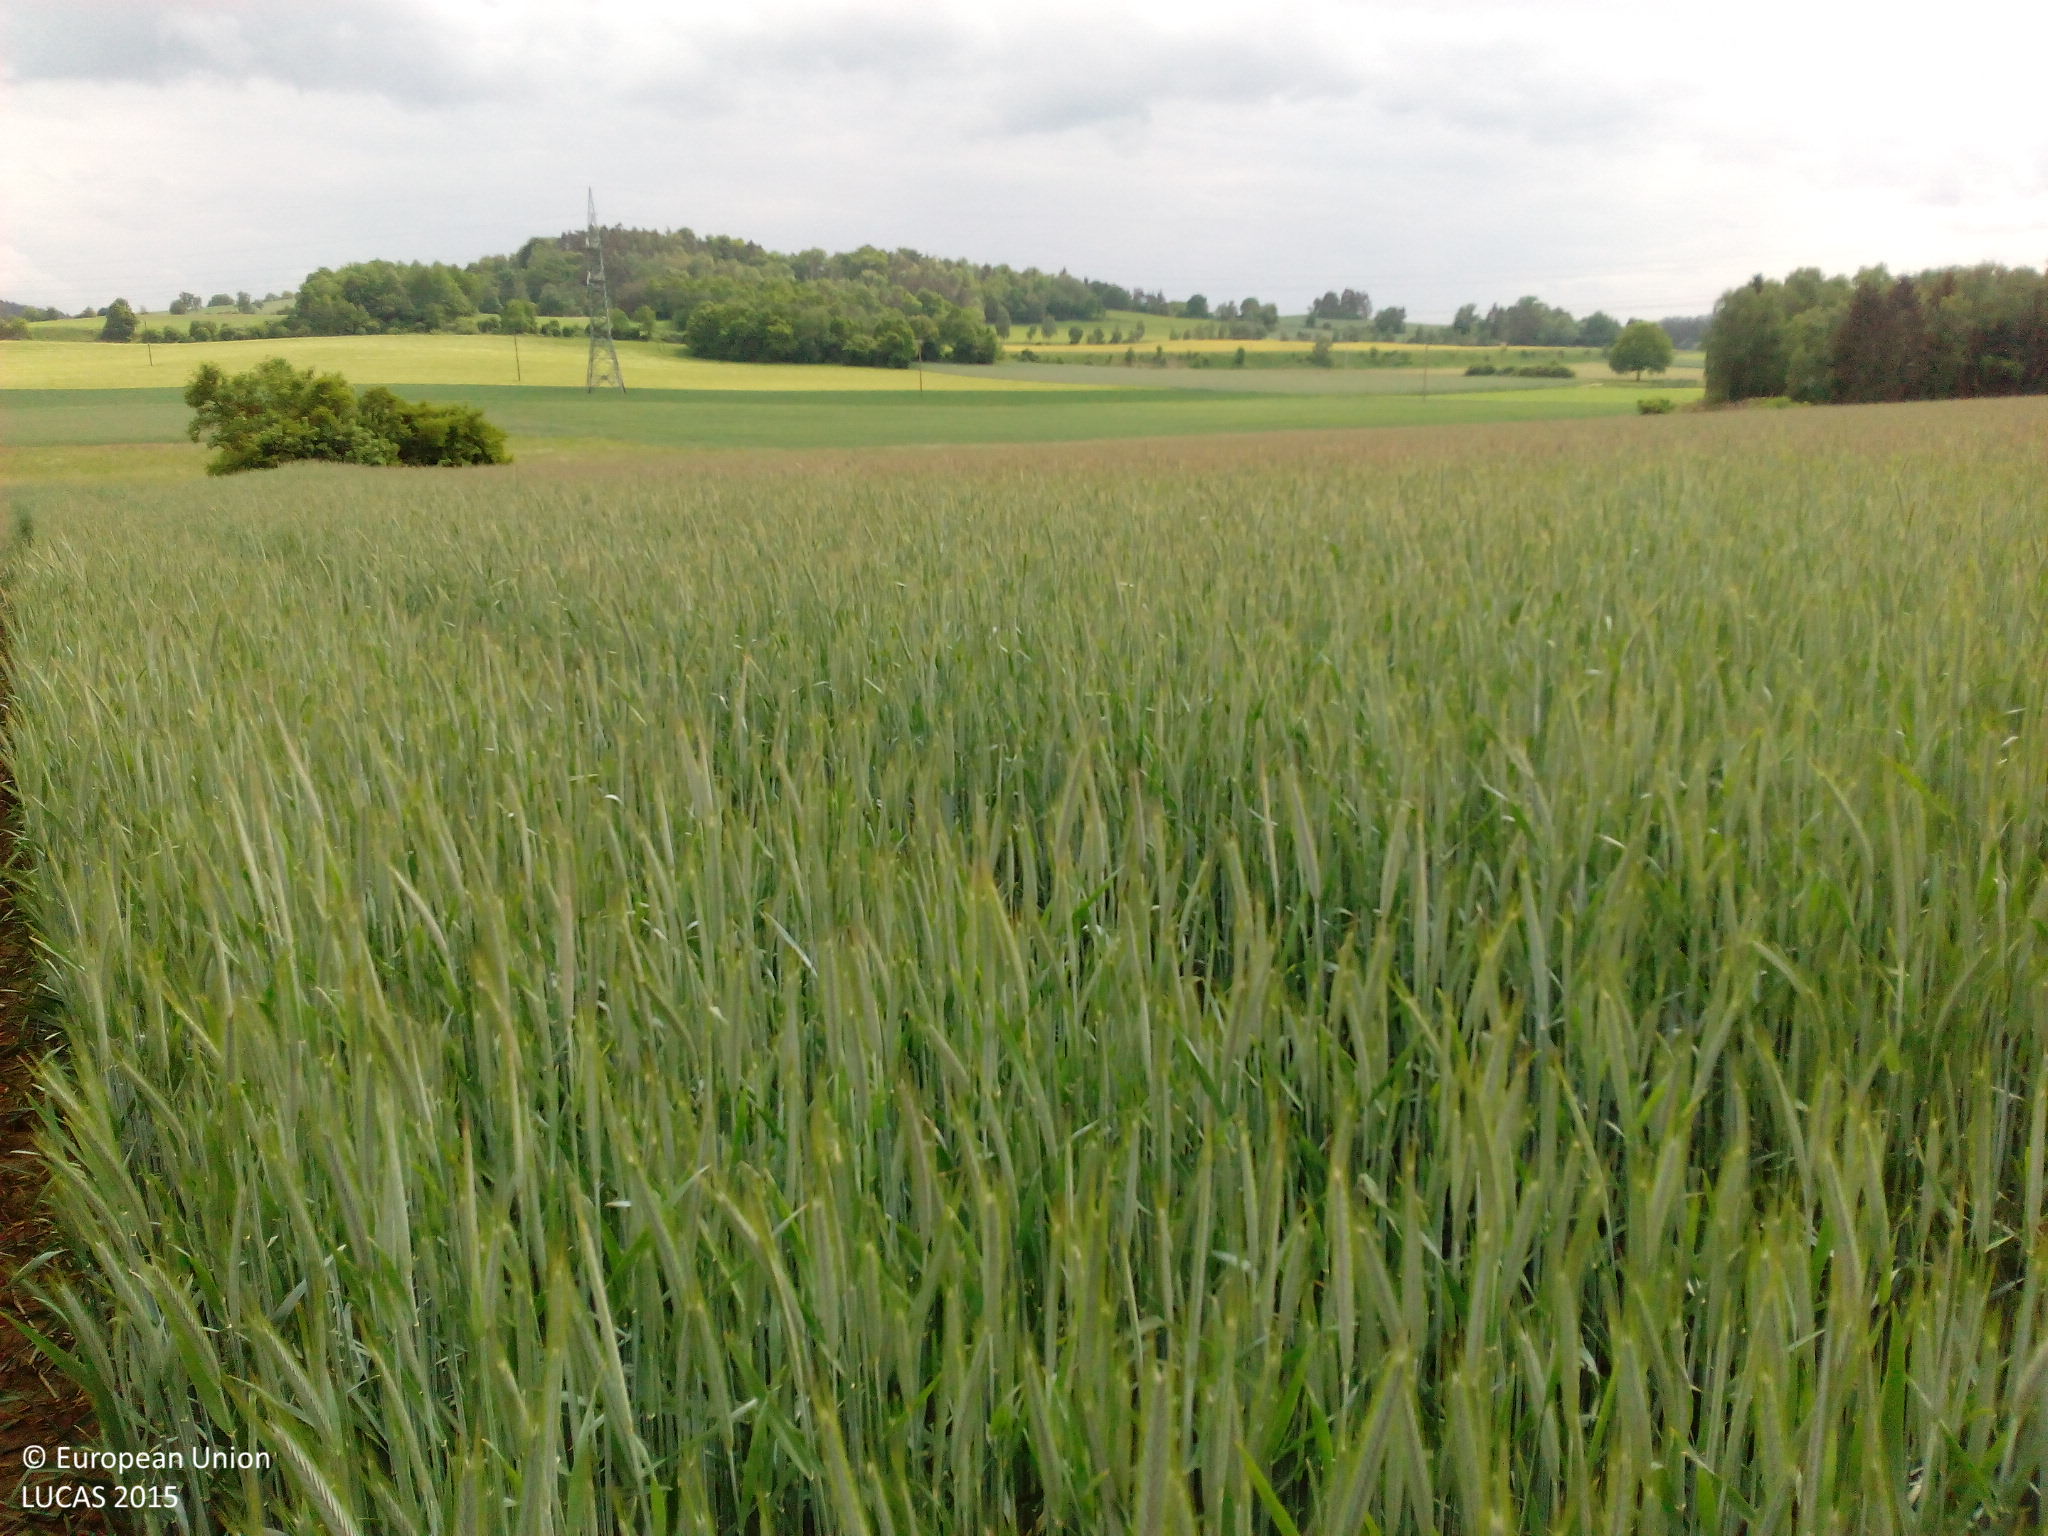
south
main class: Cropland
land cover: Rye
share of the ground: > 75 %
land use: Agriculture (excluding fallow land and kitchen gardens)
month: May
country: DE
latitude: 49.2458
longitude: 12.1836
